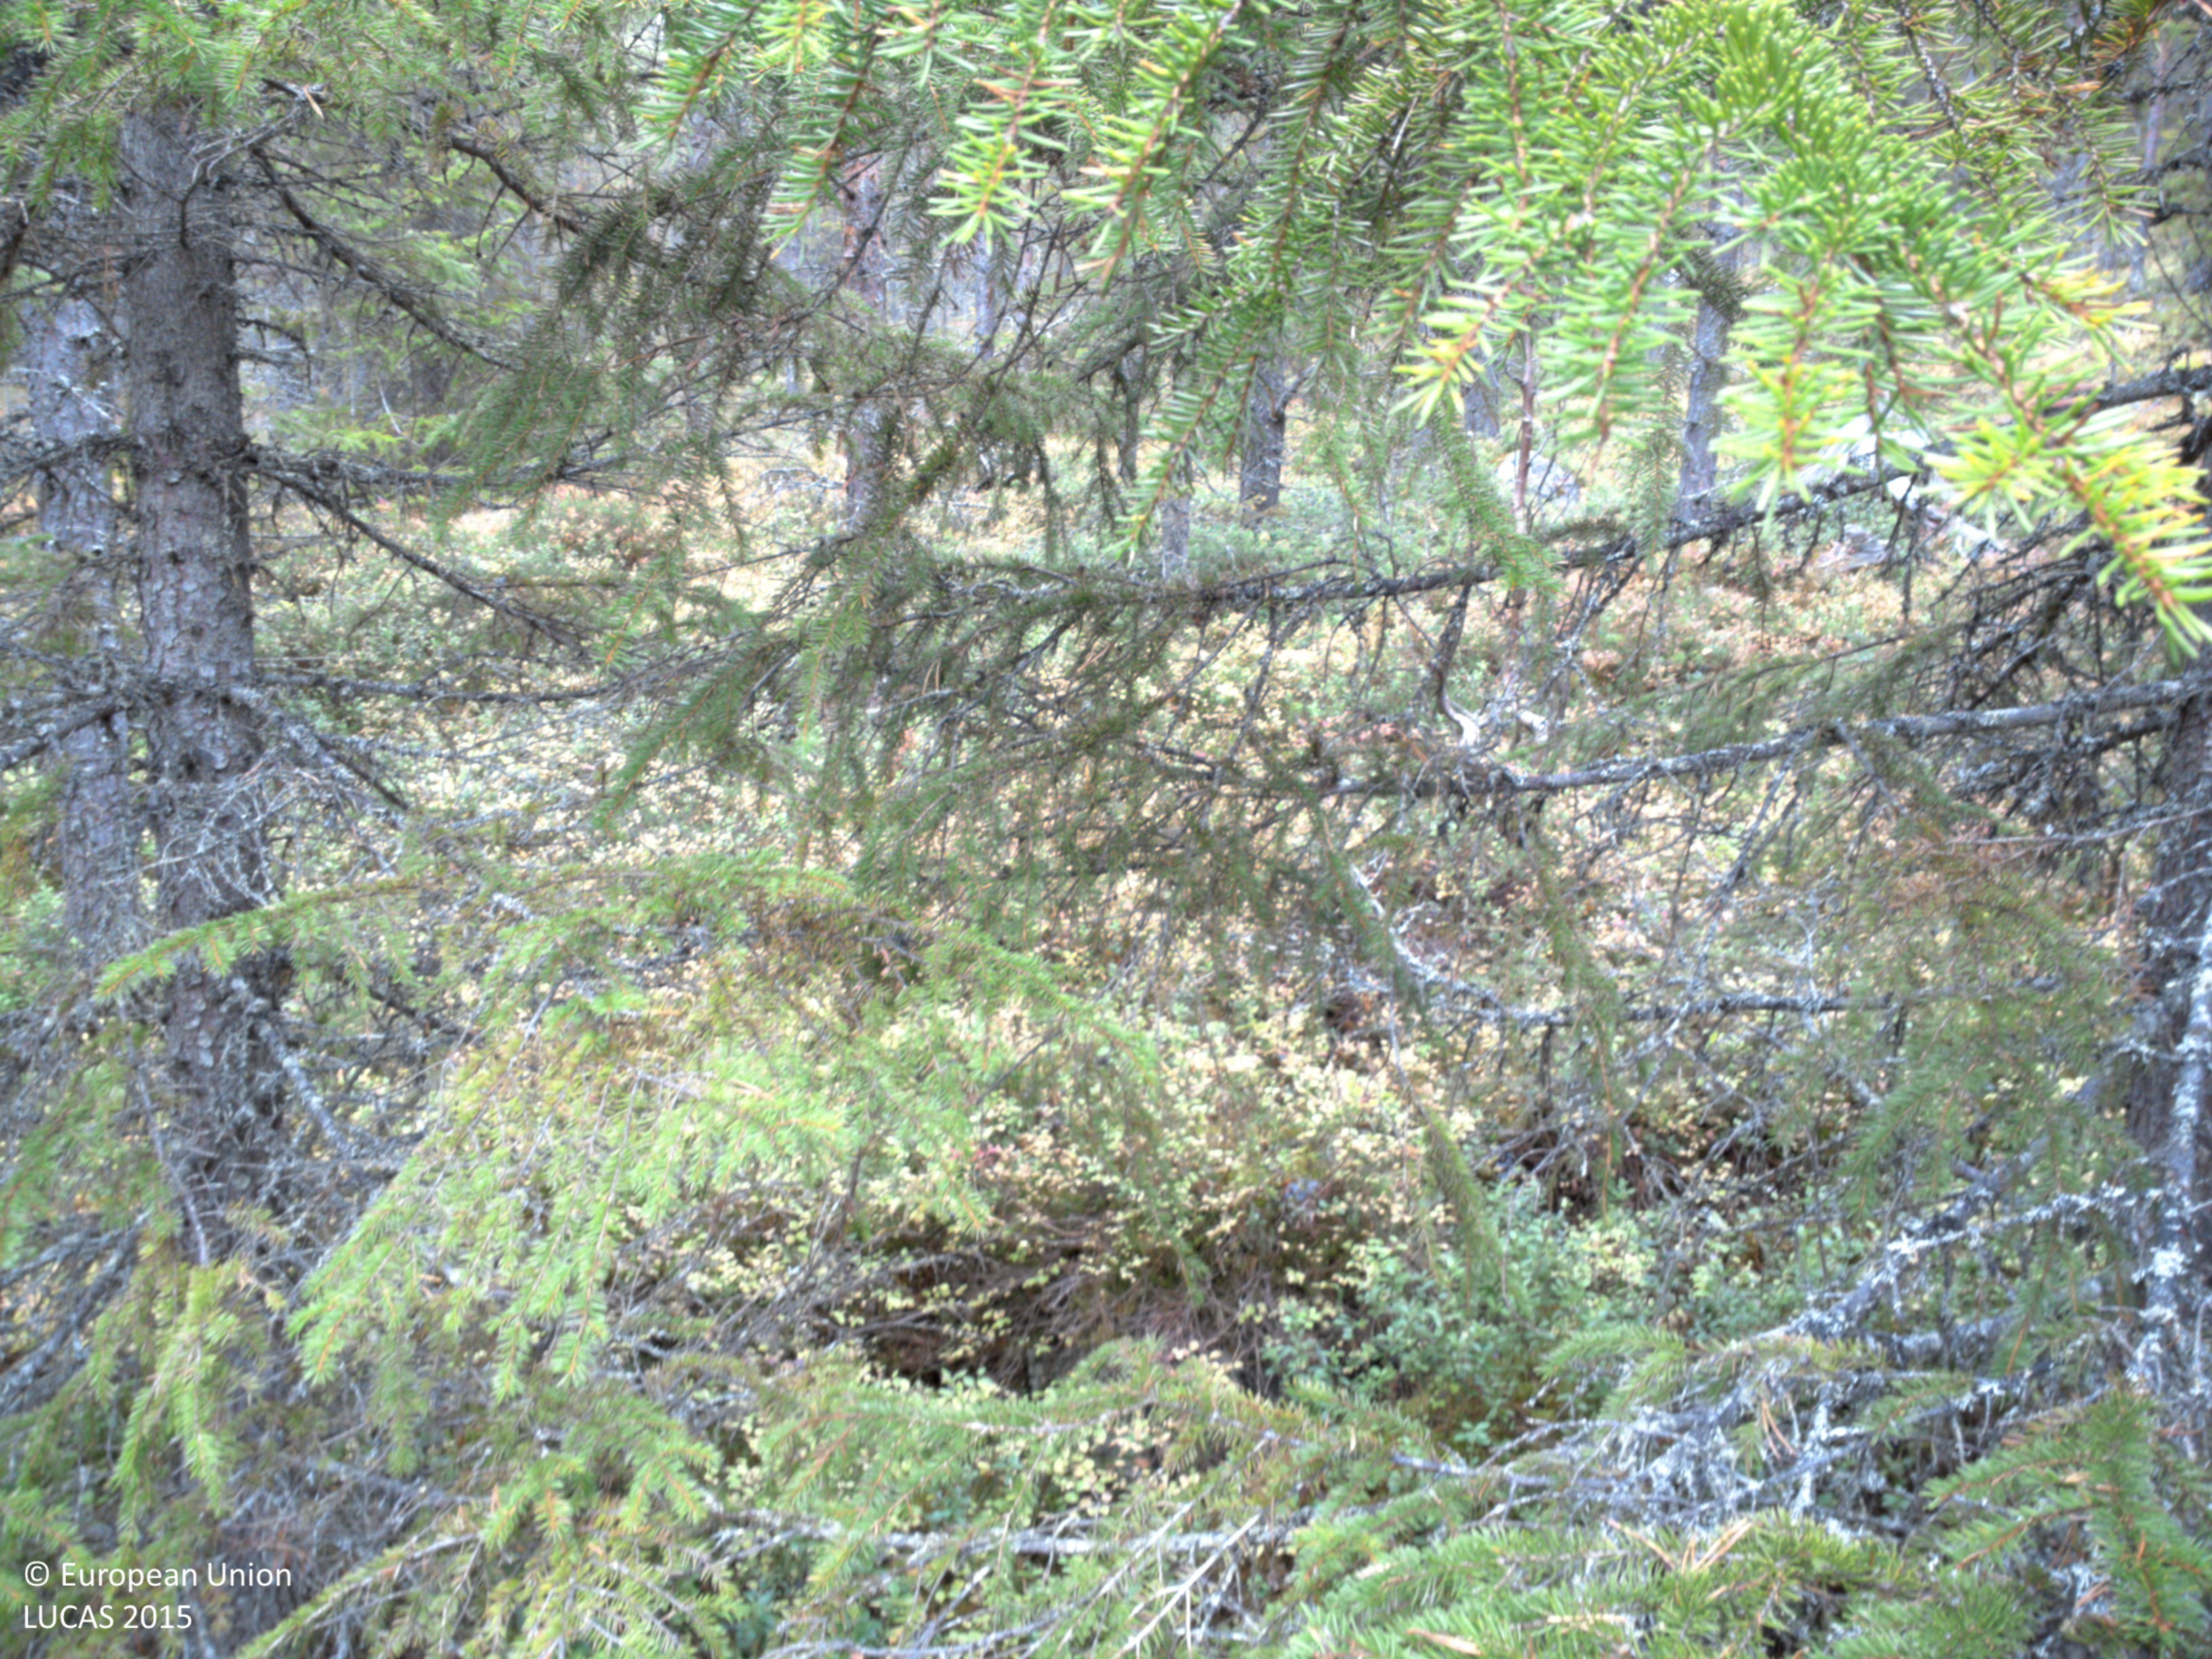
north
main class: Woodland
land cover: Other coniferous woodland
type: boreal forest
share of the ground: > 75 %
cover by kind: coniferous forest trees 80 %, shrubs 10 %, lichens and mosses 10 %
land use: Forestry
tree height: > 5 m
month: October
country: SE
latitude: 64.9536
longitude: 18.1146
